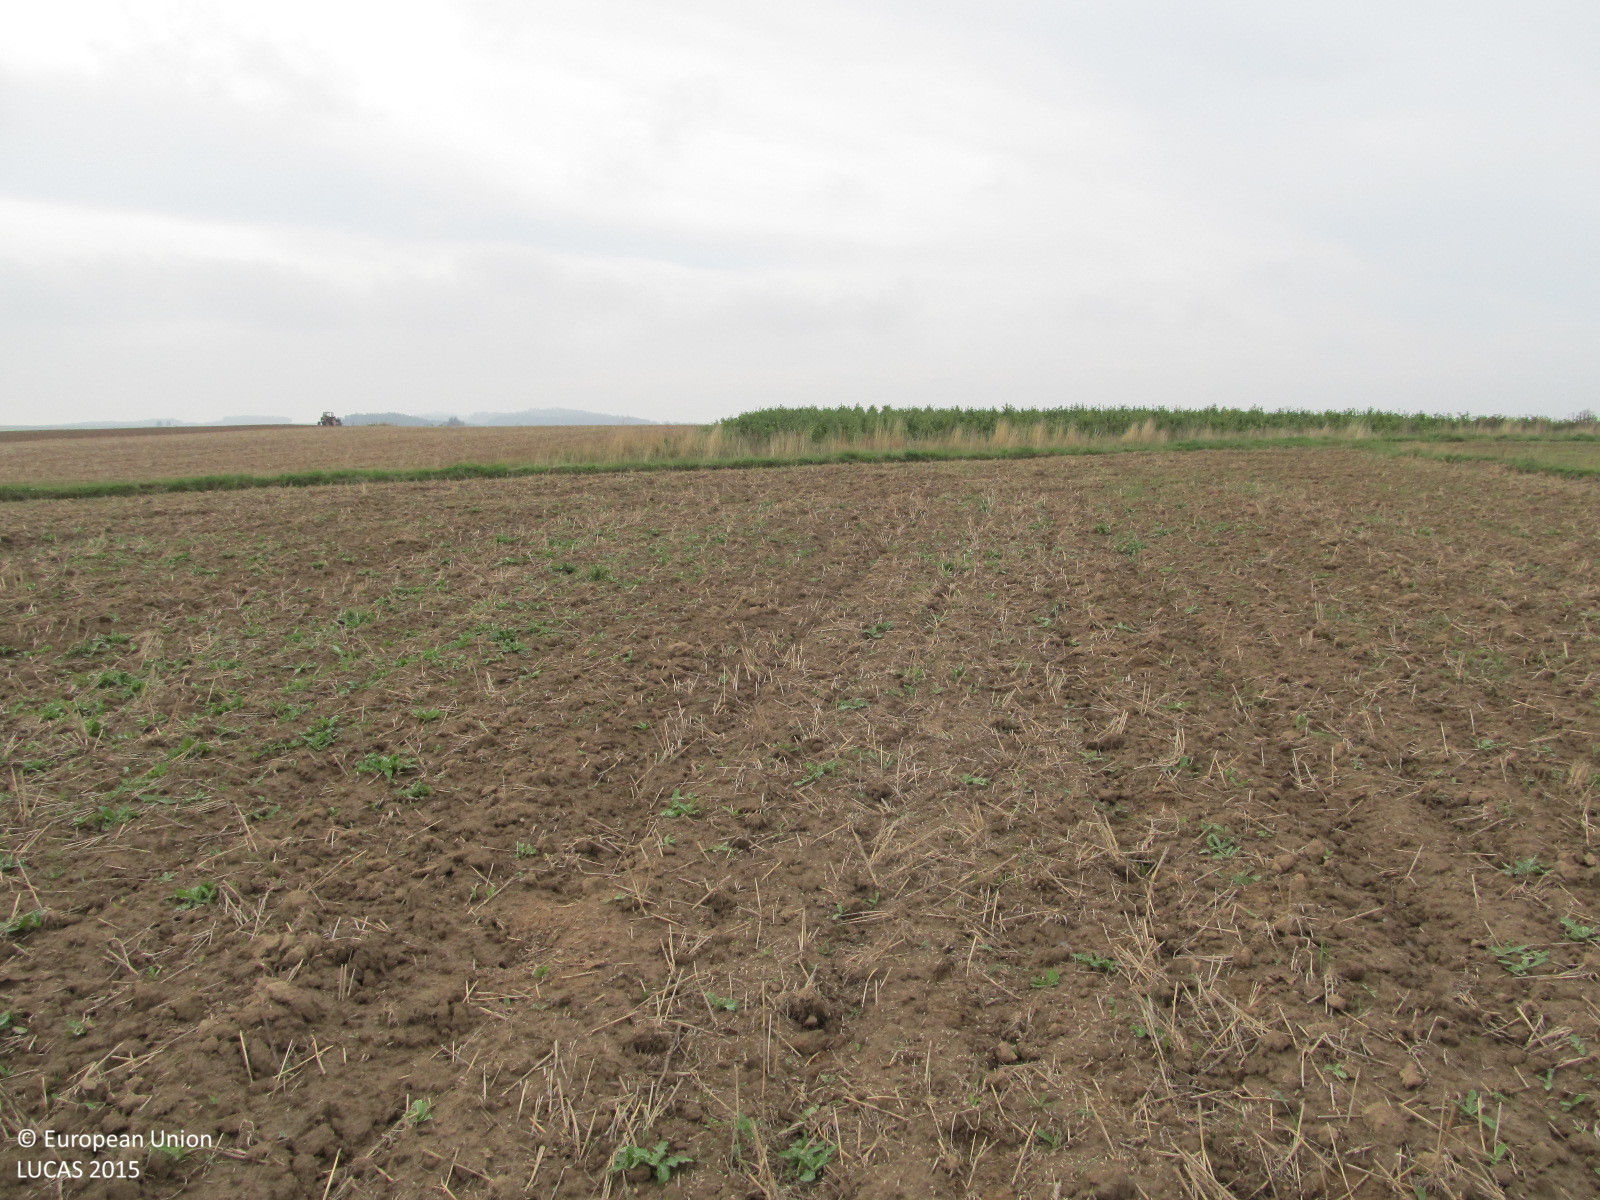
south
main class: Cropland
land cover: Common wheat
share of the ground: < 10 %
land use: Agriculture (excluding fallow land and kitchen gardens)
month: September
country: AT
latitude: 48.8964
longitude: 15.5277
